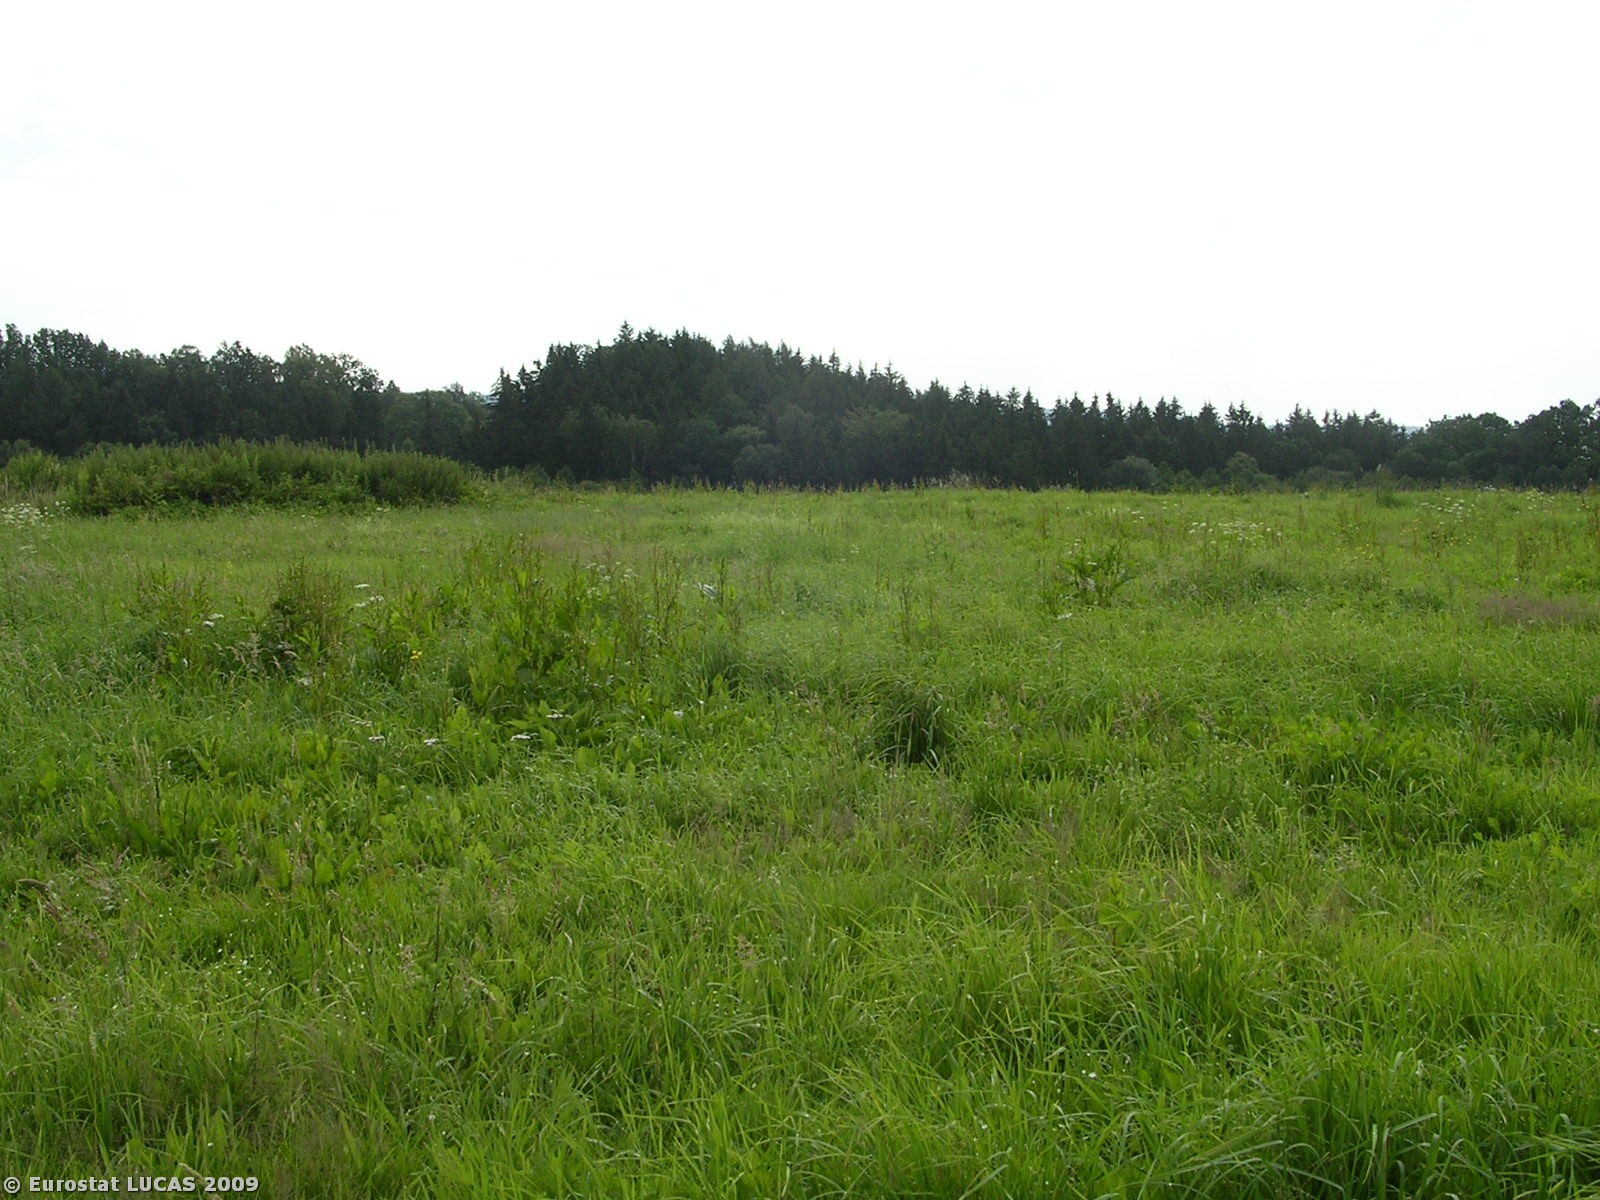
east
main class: Grassland
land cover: Grassland without tree/shrub cover
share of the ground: > 75 %
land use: Agriculture (excluding fallow land and kitchen gardens)
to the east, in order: Grassland without tree/shrub cover; Abandoned hedges; Grassland without tree/shrub cover
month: July
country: CZ
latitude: 50.7948
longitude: 15.0109
